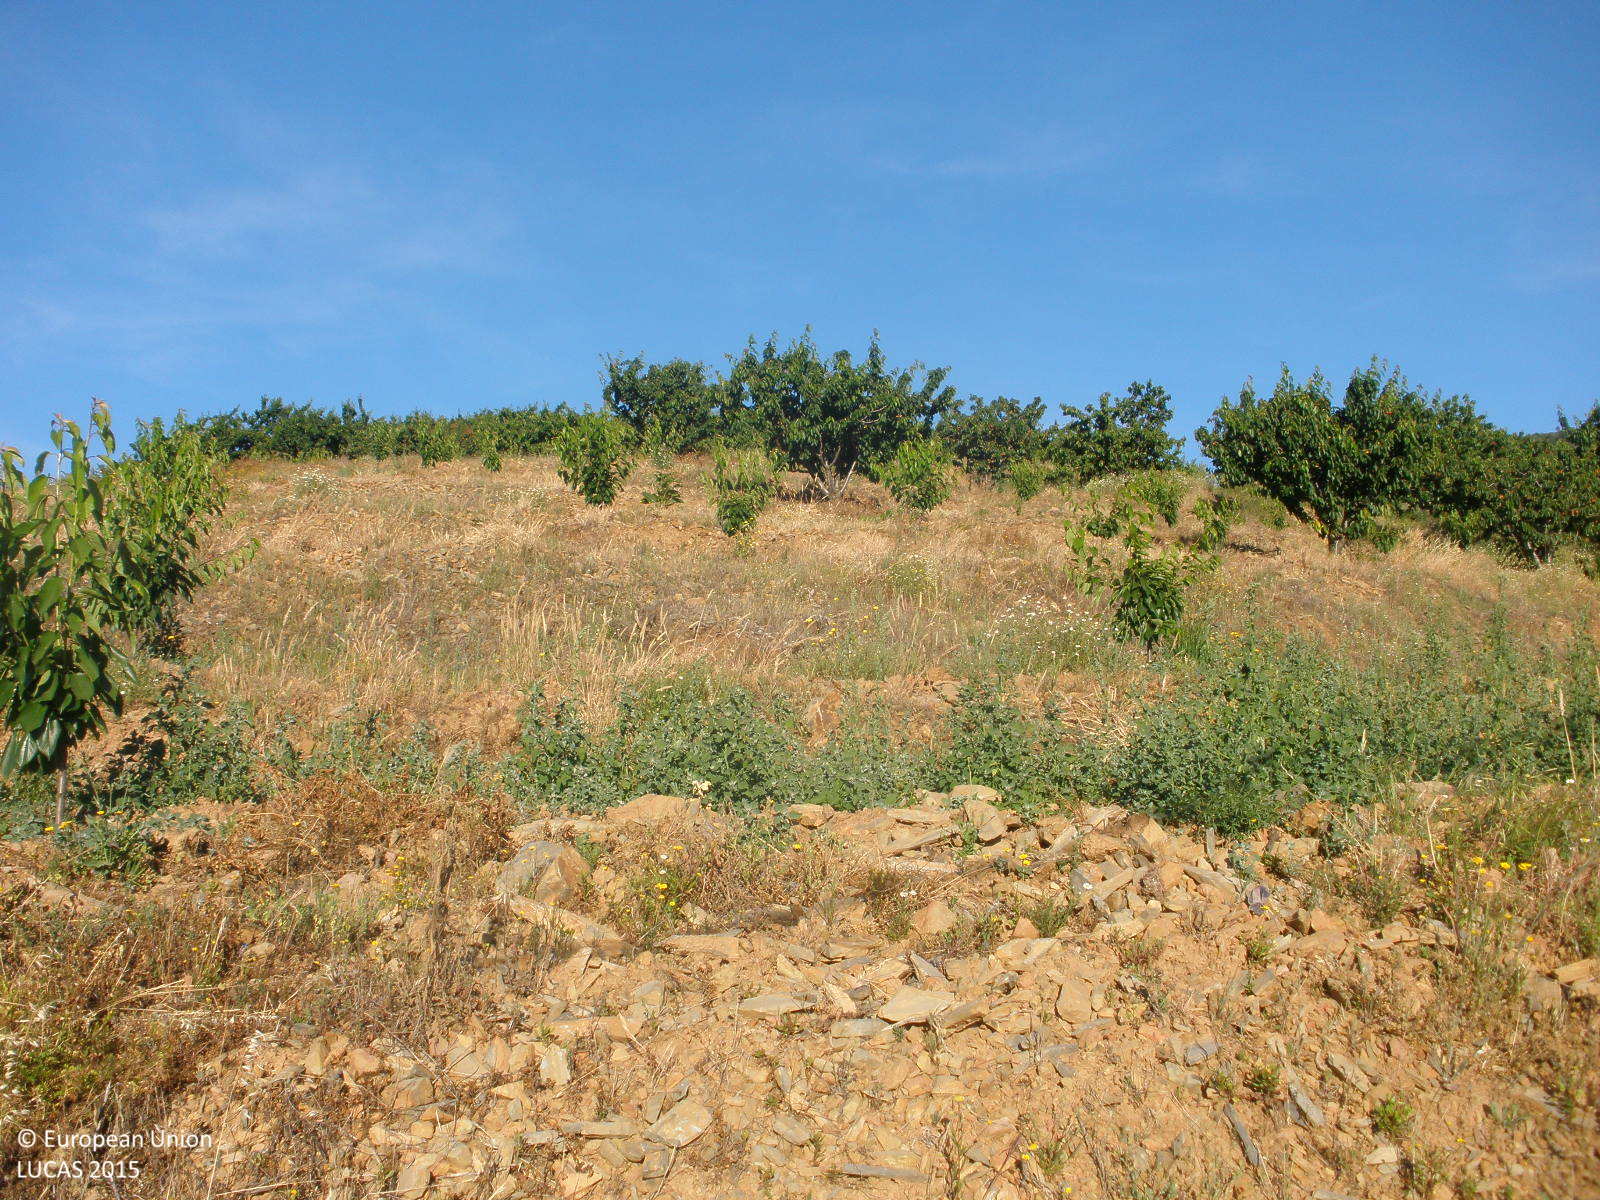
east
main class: Cropland
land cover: Cherry fruit
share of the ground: 10 - 25 %
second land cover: Spontaneously vegetated surfaces
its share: 10 - 25 %
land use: Agriculture (excluding fallow land and kitchen gardens)
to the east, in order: Cherry fruit; Spontaneously vegetated surfaces; Tracks; Cherry fruit; Tracks; Cherry fruit; Tracks; Cherry fruit
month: May
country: ES
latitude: 40.2927
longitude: -6.3021
